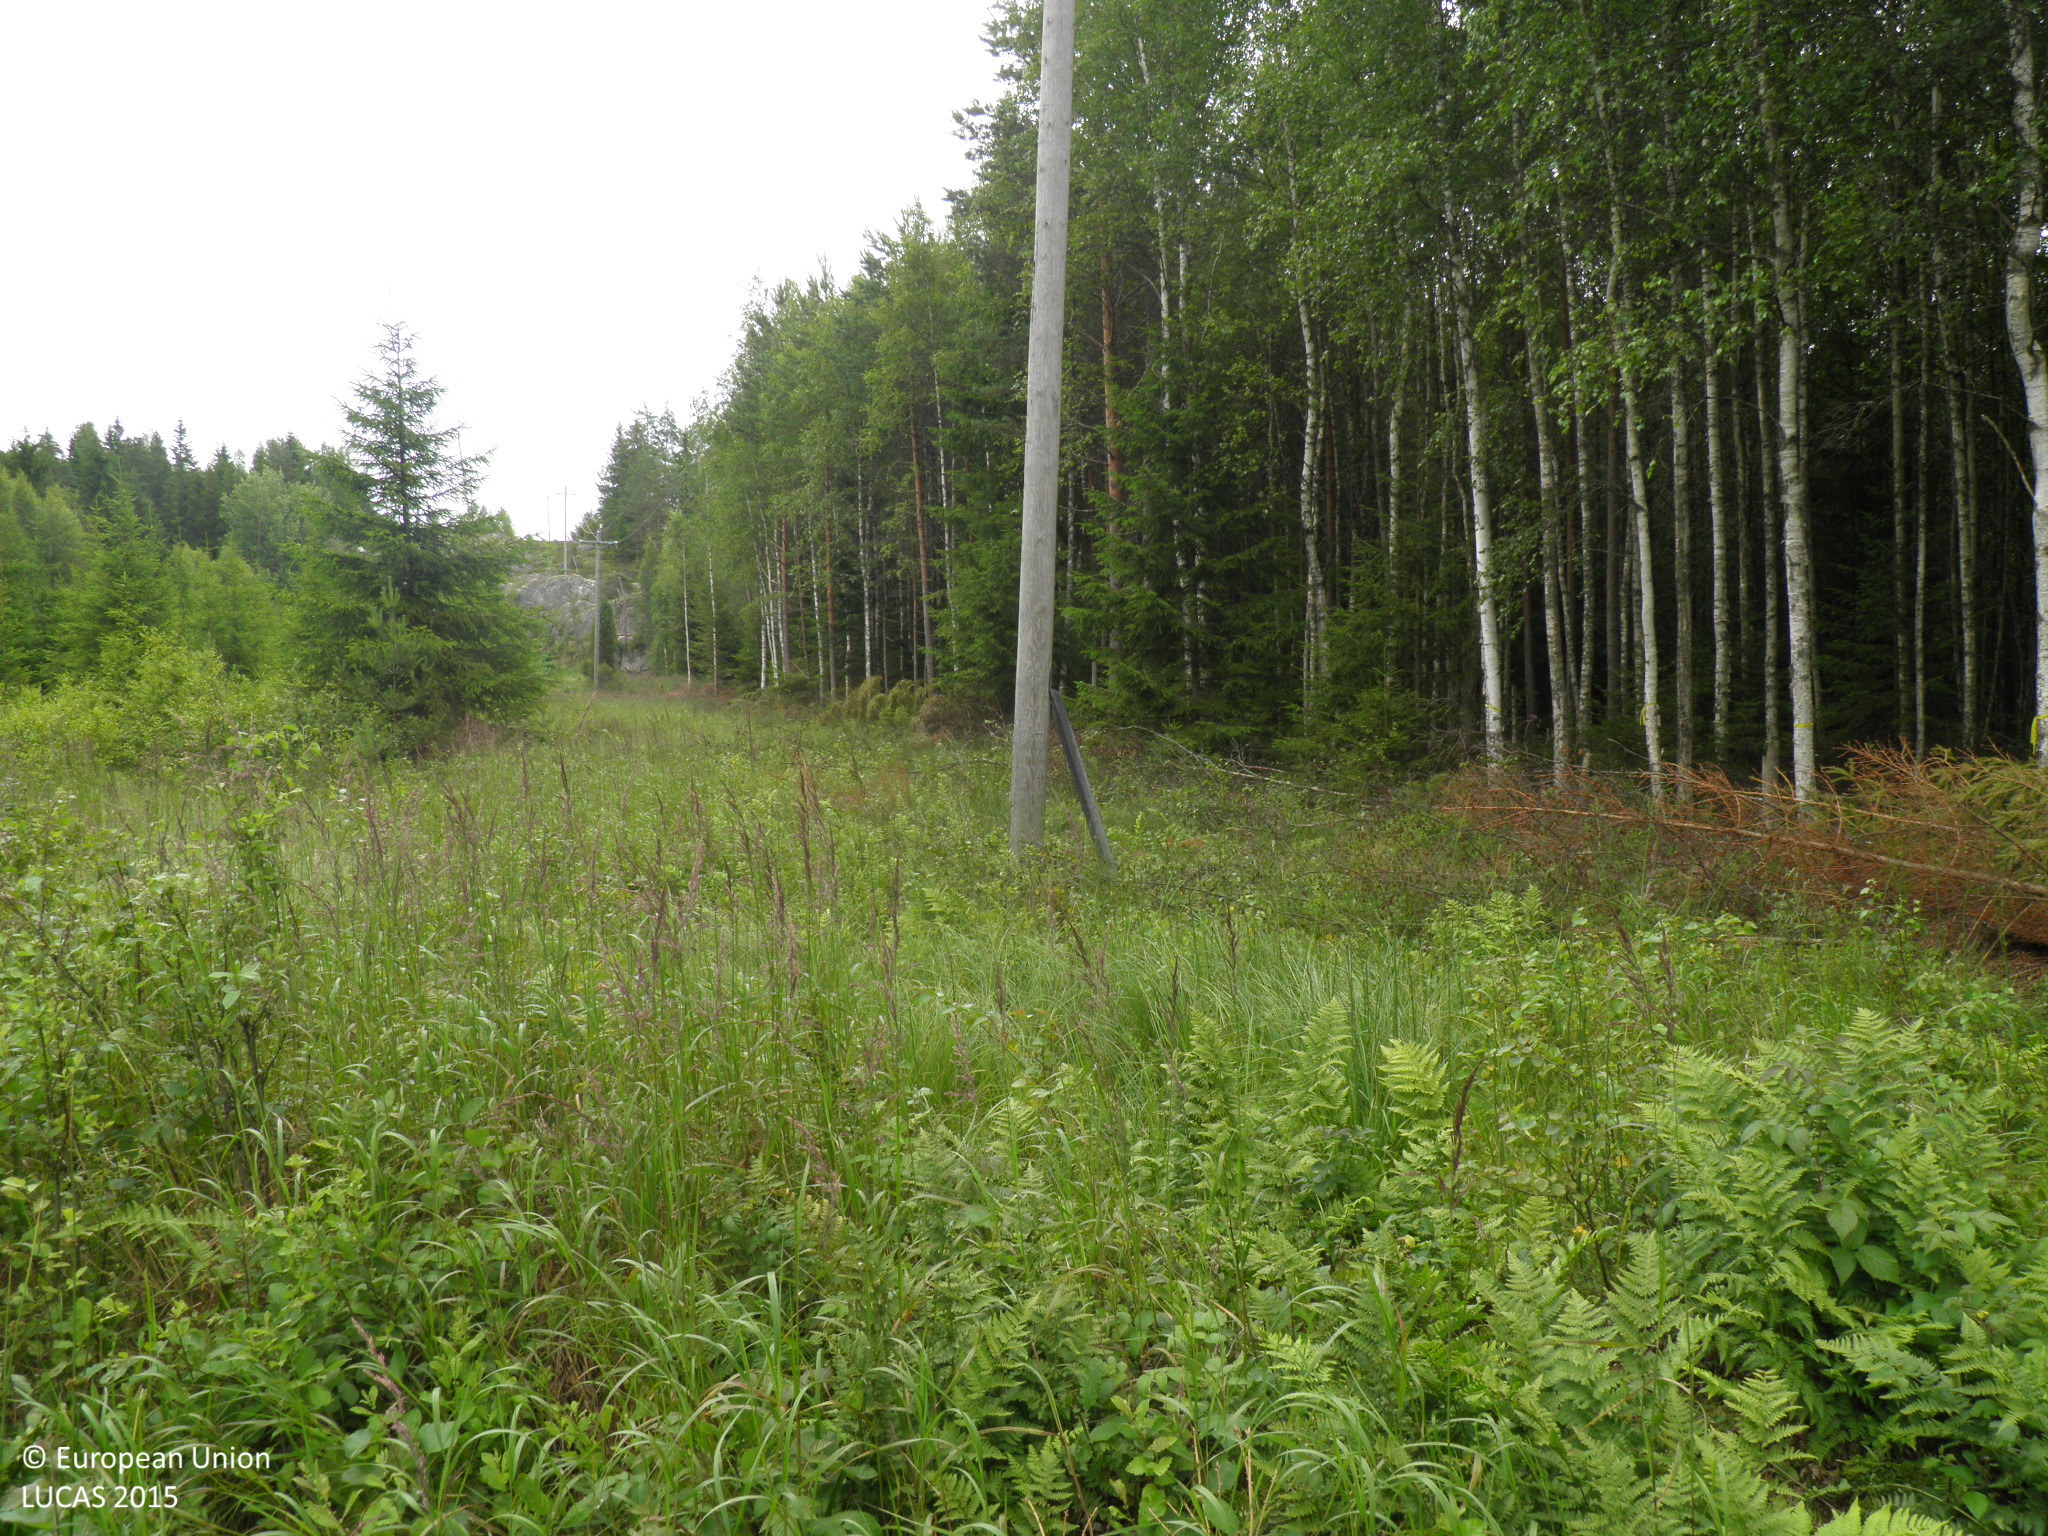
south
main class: Artificial land
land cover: Other artificial areas
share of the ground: > 75 %
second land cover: Shrubland with sparse tree cover
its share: > 75 %
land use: Electricity, gas and thermal power distribution
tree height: < 5 m
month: July
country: FI
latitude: 60.2157
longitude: 22.8004
